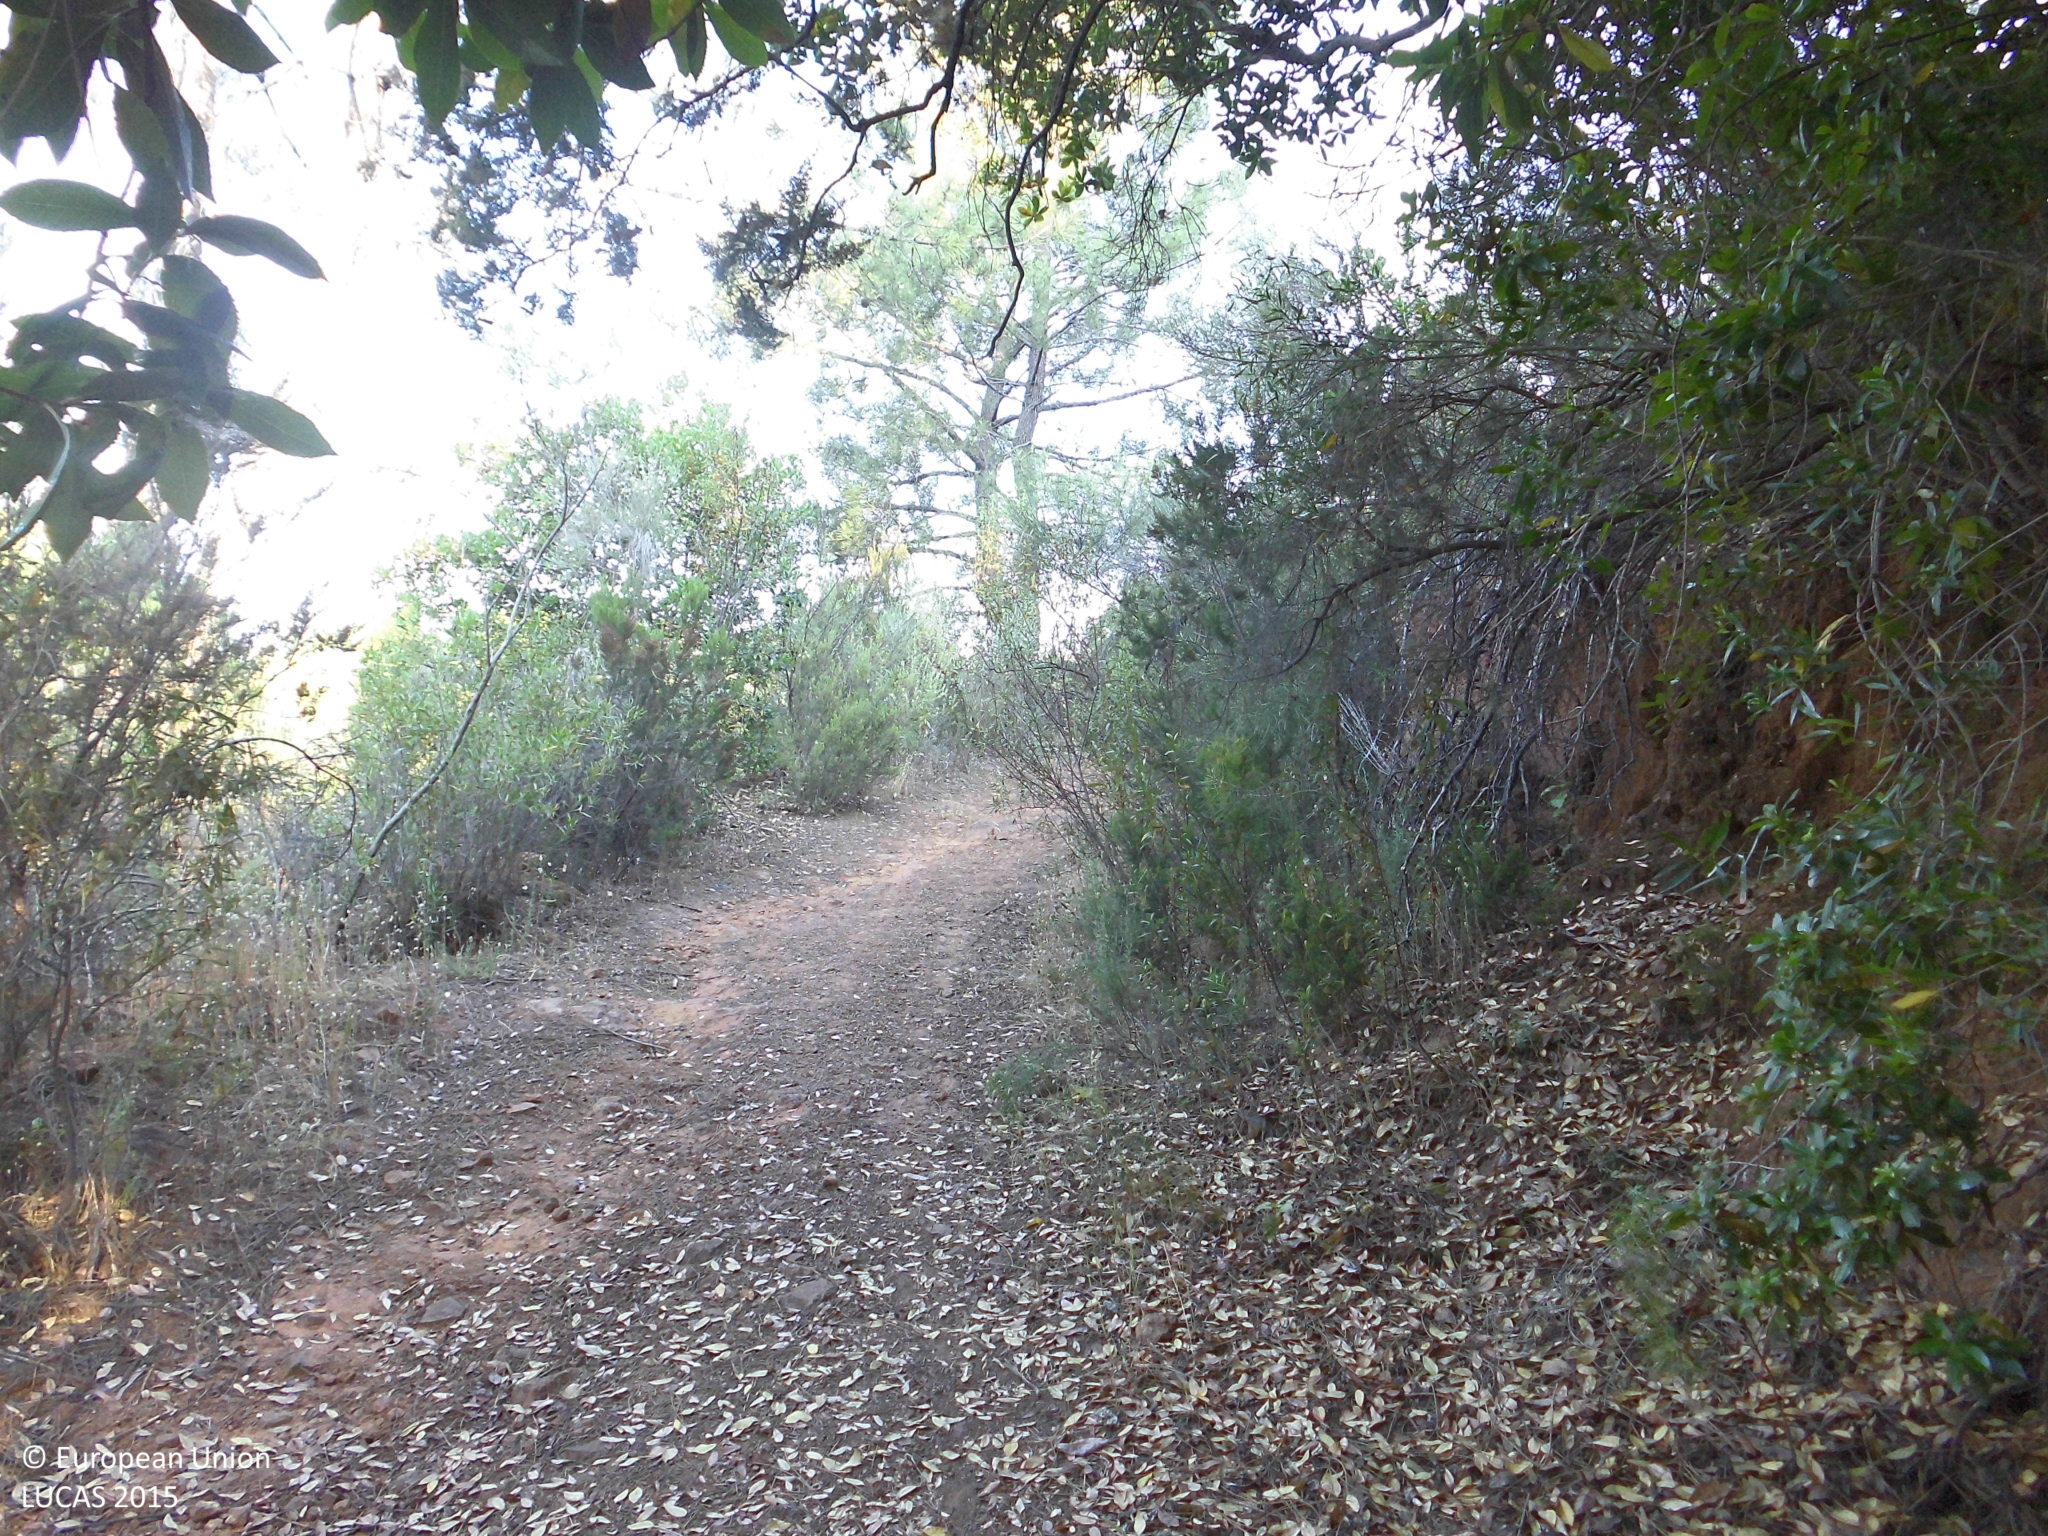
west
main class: Woodland
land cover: Pine dominated mixed woodland
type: thermophilous deciduous forest
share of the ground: > 75 %
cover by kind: coniferous forest trees 50 %, broadleaved forest trees 25 %, shrubs 20 %, herbaceous plants 5 %
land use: Forestry
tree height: > 5 m
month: June
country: ES
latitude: 40.1169
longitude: -5.4668
